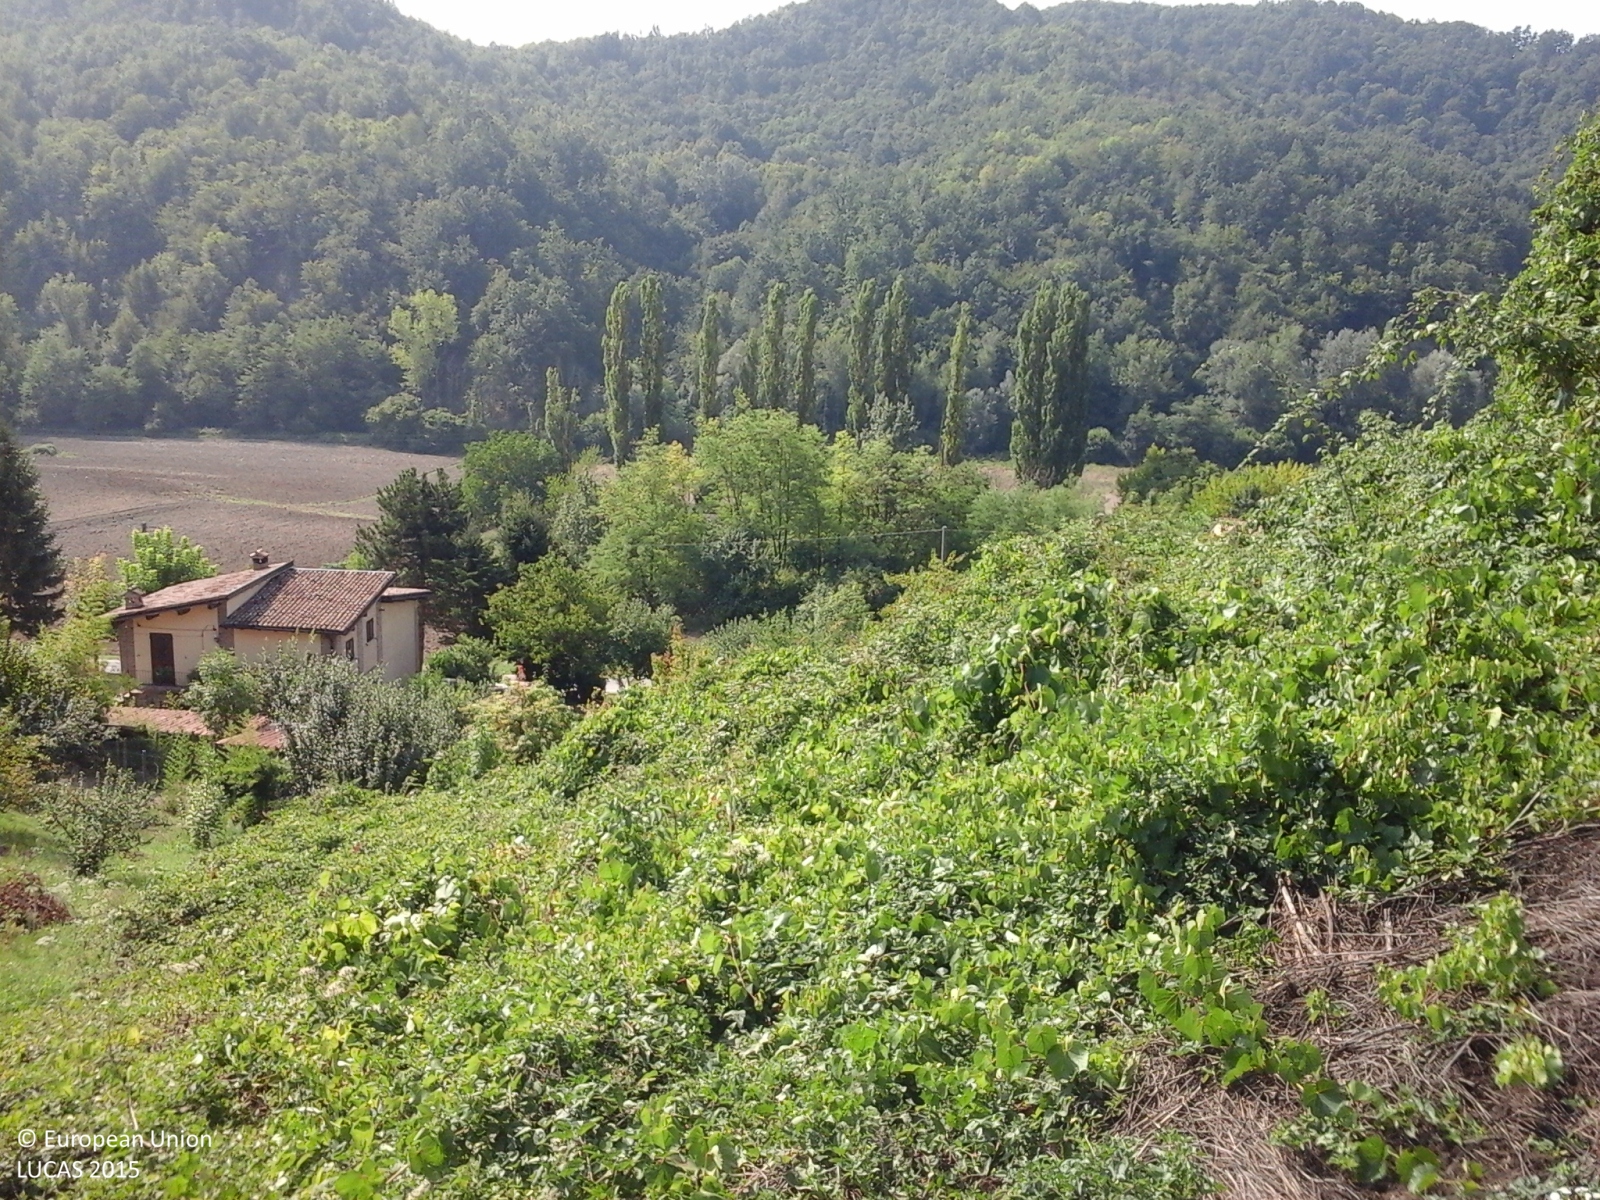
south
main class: Cropland
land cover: Lucerne
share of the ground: > 75 %
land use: Agriculture (excluding fallow land and kitchen gardens)
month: August
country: IT
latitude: 44.9063
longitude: 9.1784
